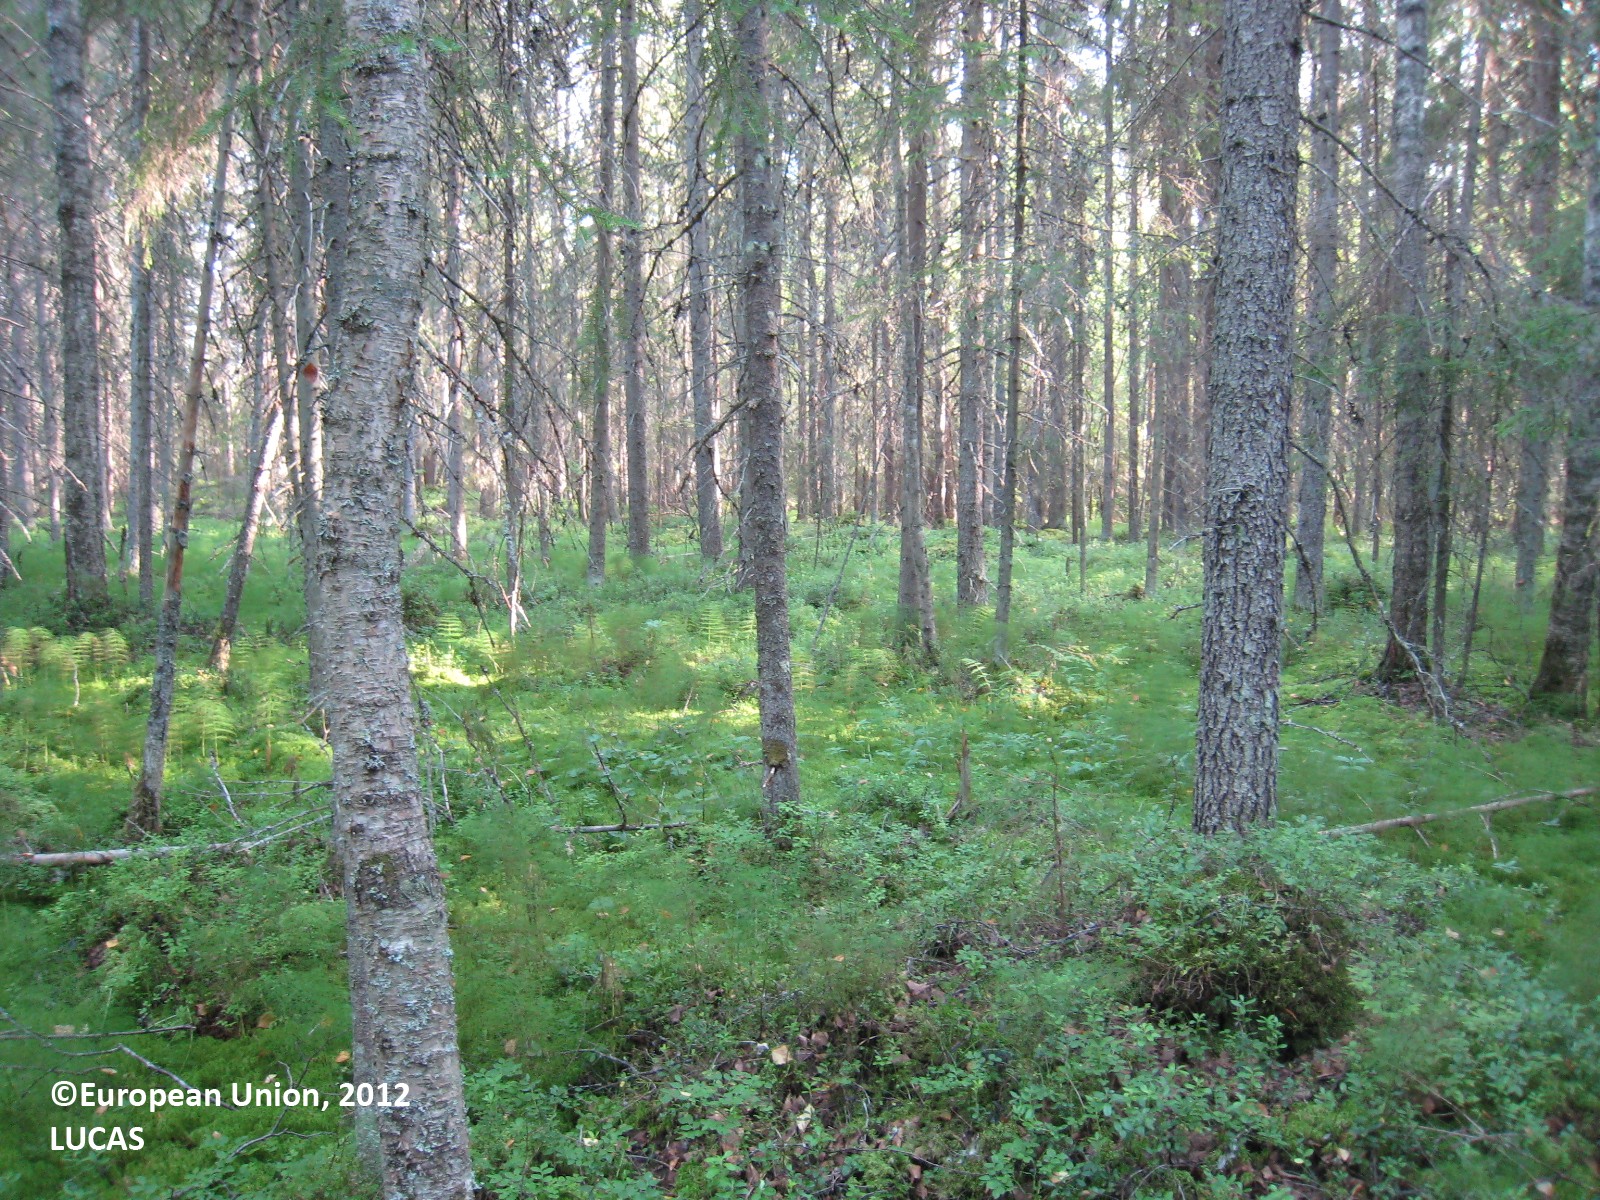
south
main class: Woodland
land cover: Spruce dominated mixed woodland
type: mire and swamp forests
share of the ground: > 75 %
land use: Forestry
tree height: > 5 m
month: July
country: FI
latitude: 62.5892
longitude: 27.3946
